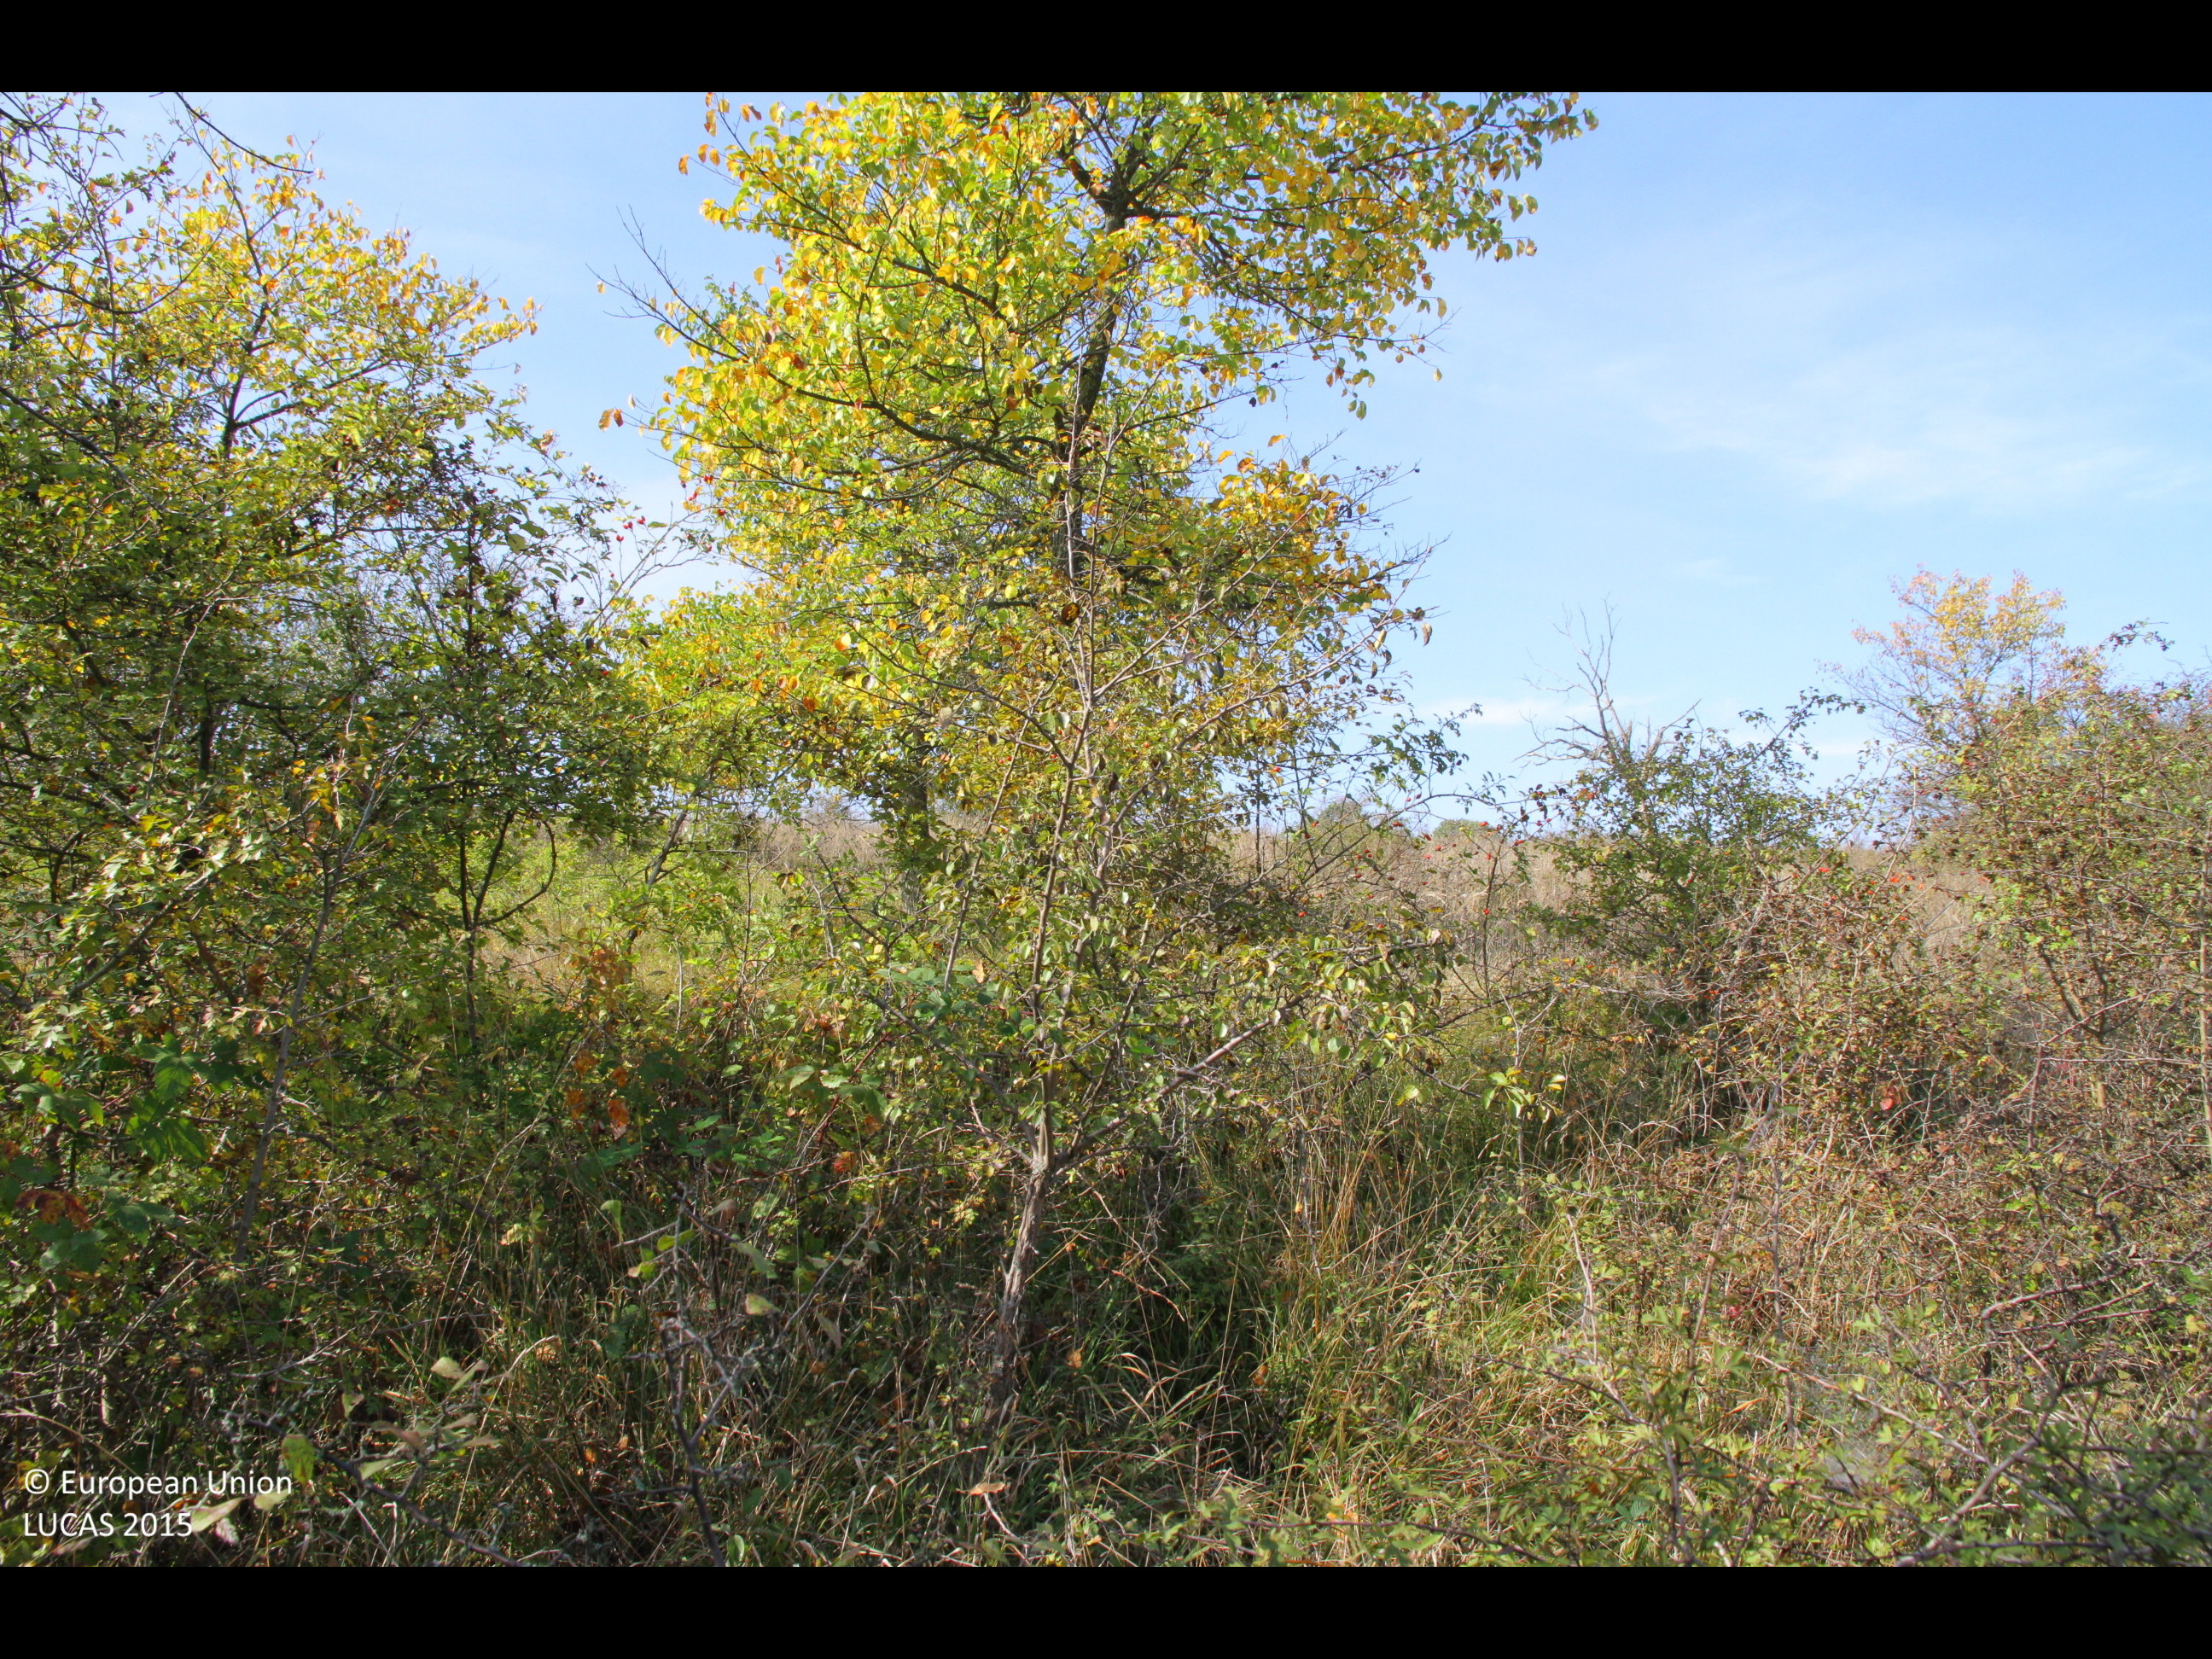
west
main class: Grassland
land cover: Grassland with sparse tree/shrub cover
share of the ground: > 75 %
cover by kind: herbaceous plants 85 %, shrubs 10 %, broadleaved forest trees 5 %
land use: Agriculture (excluding fallow land and kitchen gardens)
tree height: > 5 m
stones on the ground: < 10 %
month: October
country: BG
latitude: 43.0659
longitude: 27.0976
